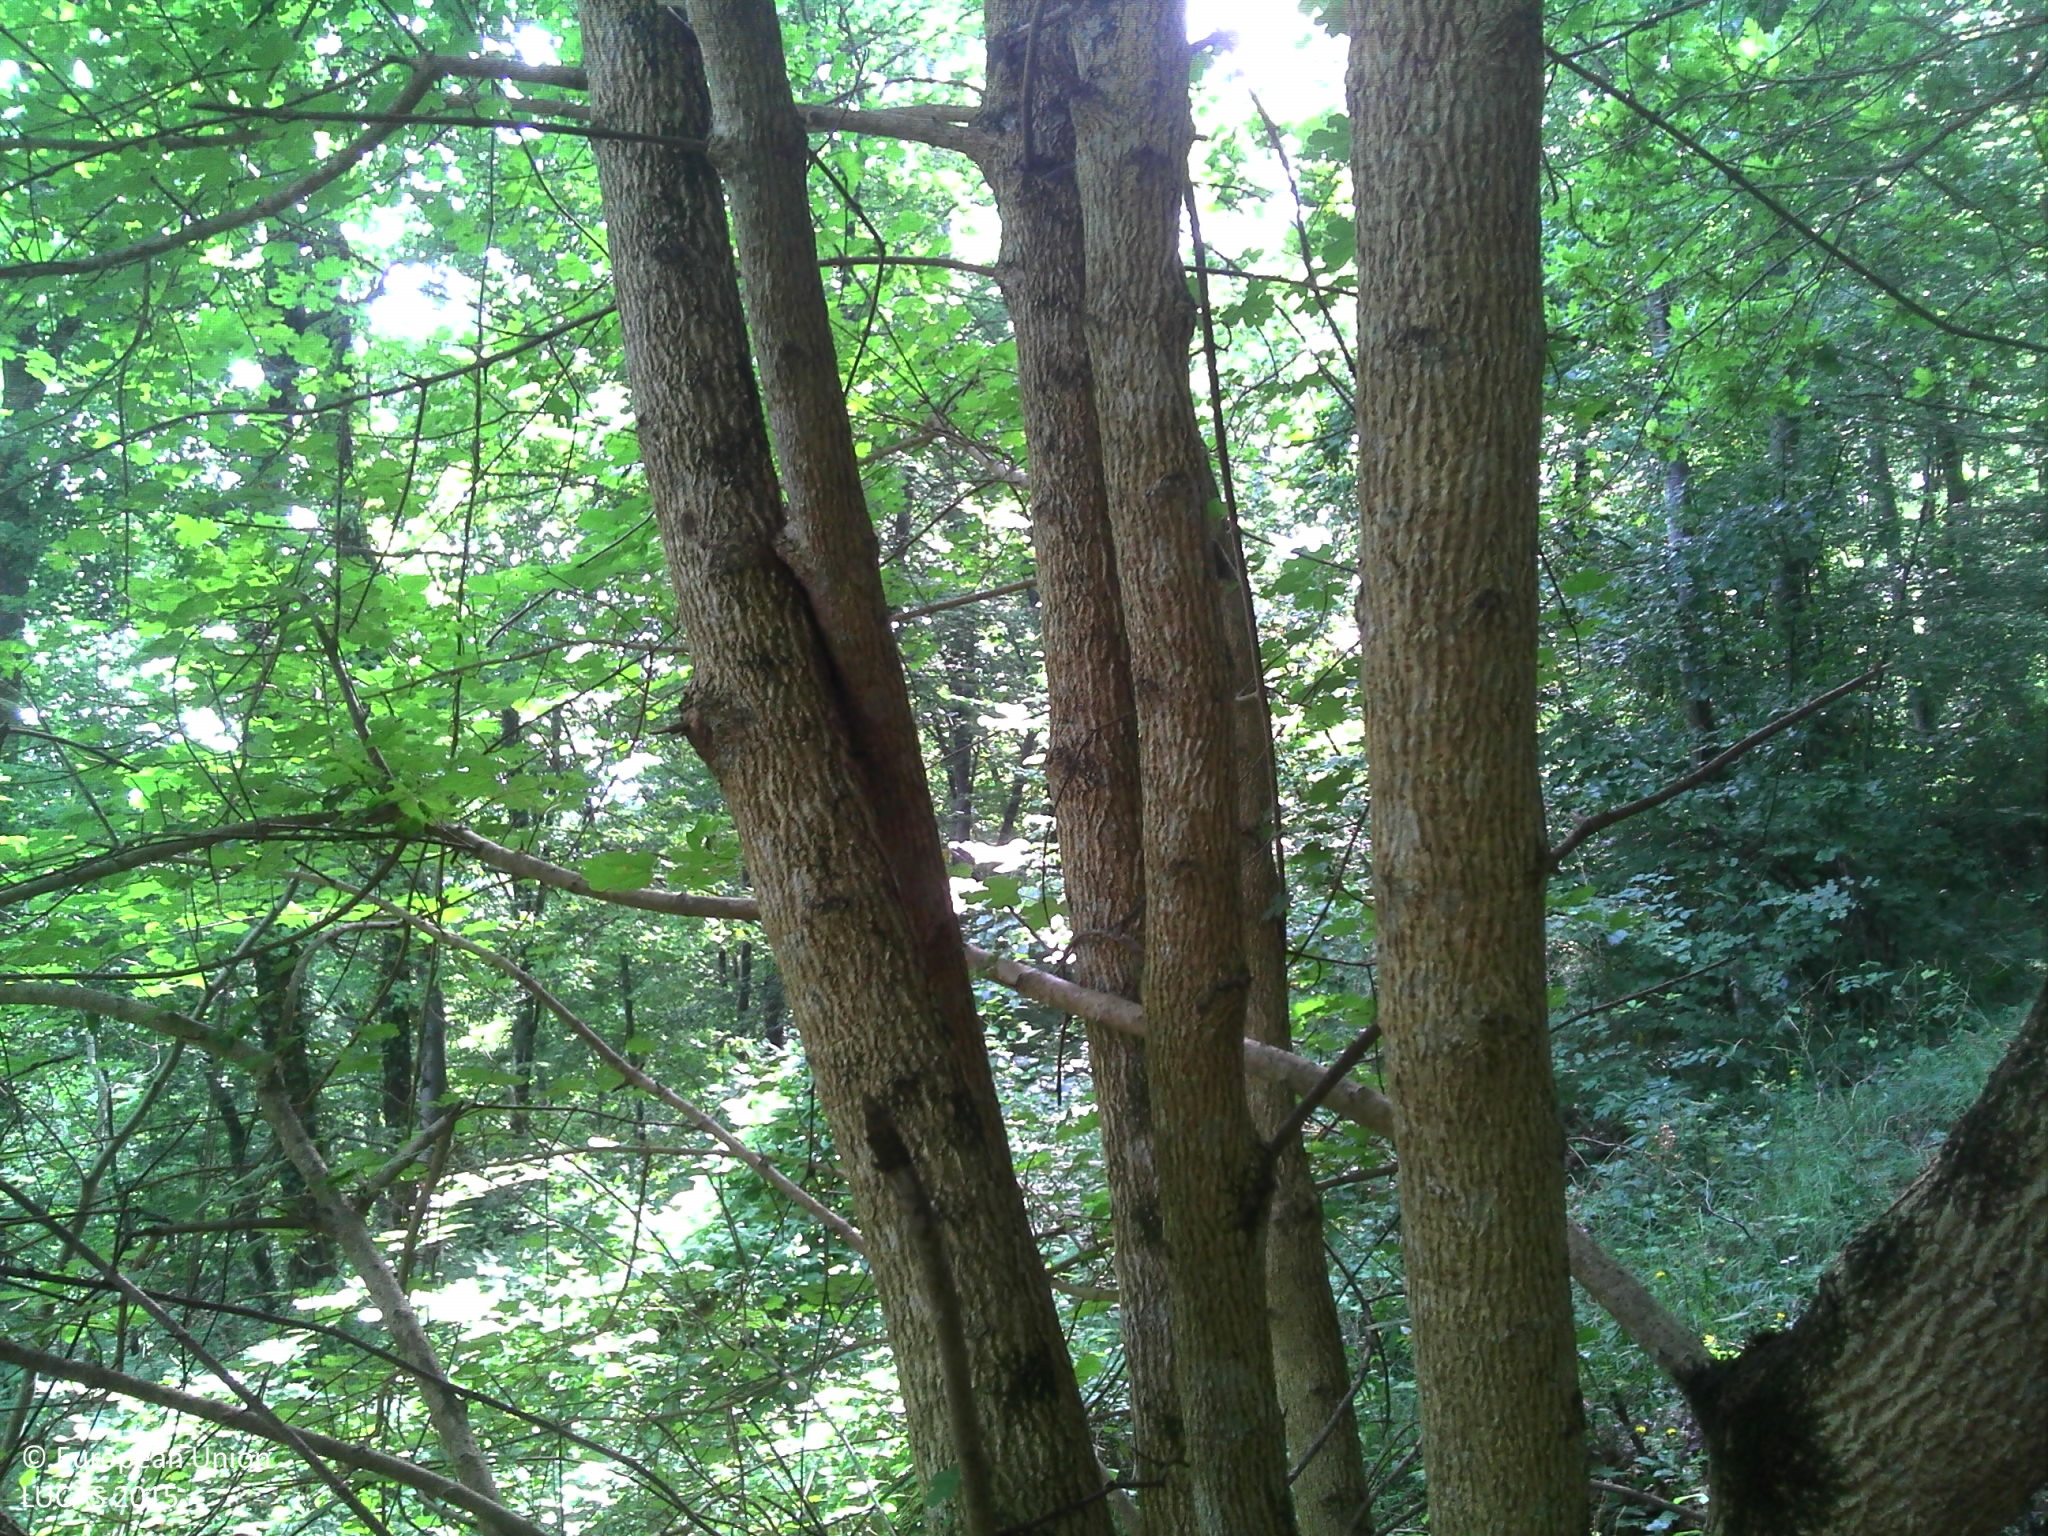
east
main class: Woodland
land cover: Broadleaved woodland
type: acidophilous oak and oak-birch forest
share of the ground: > 75 %
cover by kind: broadleaved forest trees 100 %
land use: Forestry
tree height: > 5 m
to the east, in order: Broadleaved woodland
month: July
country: FR
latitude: 43.1615
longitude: 1.0125
